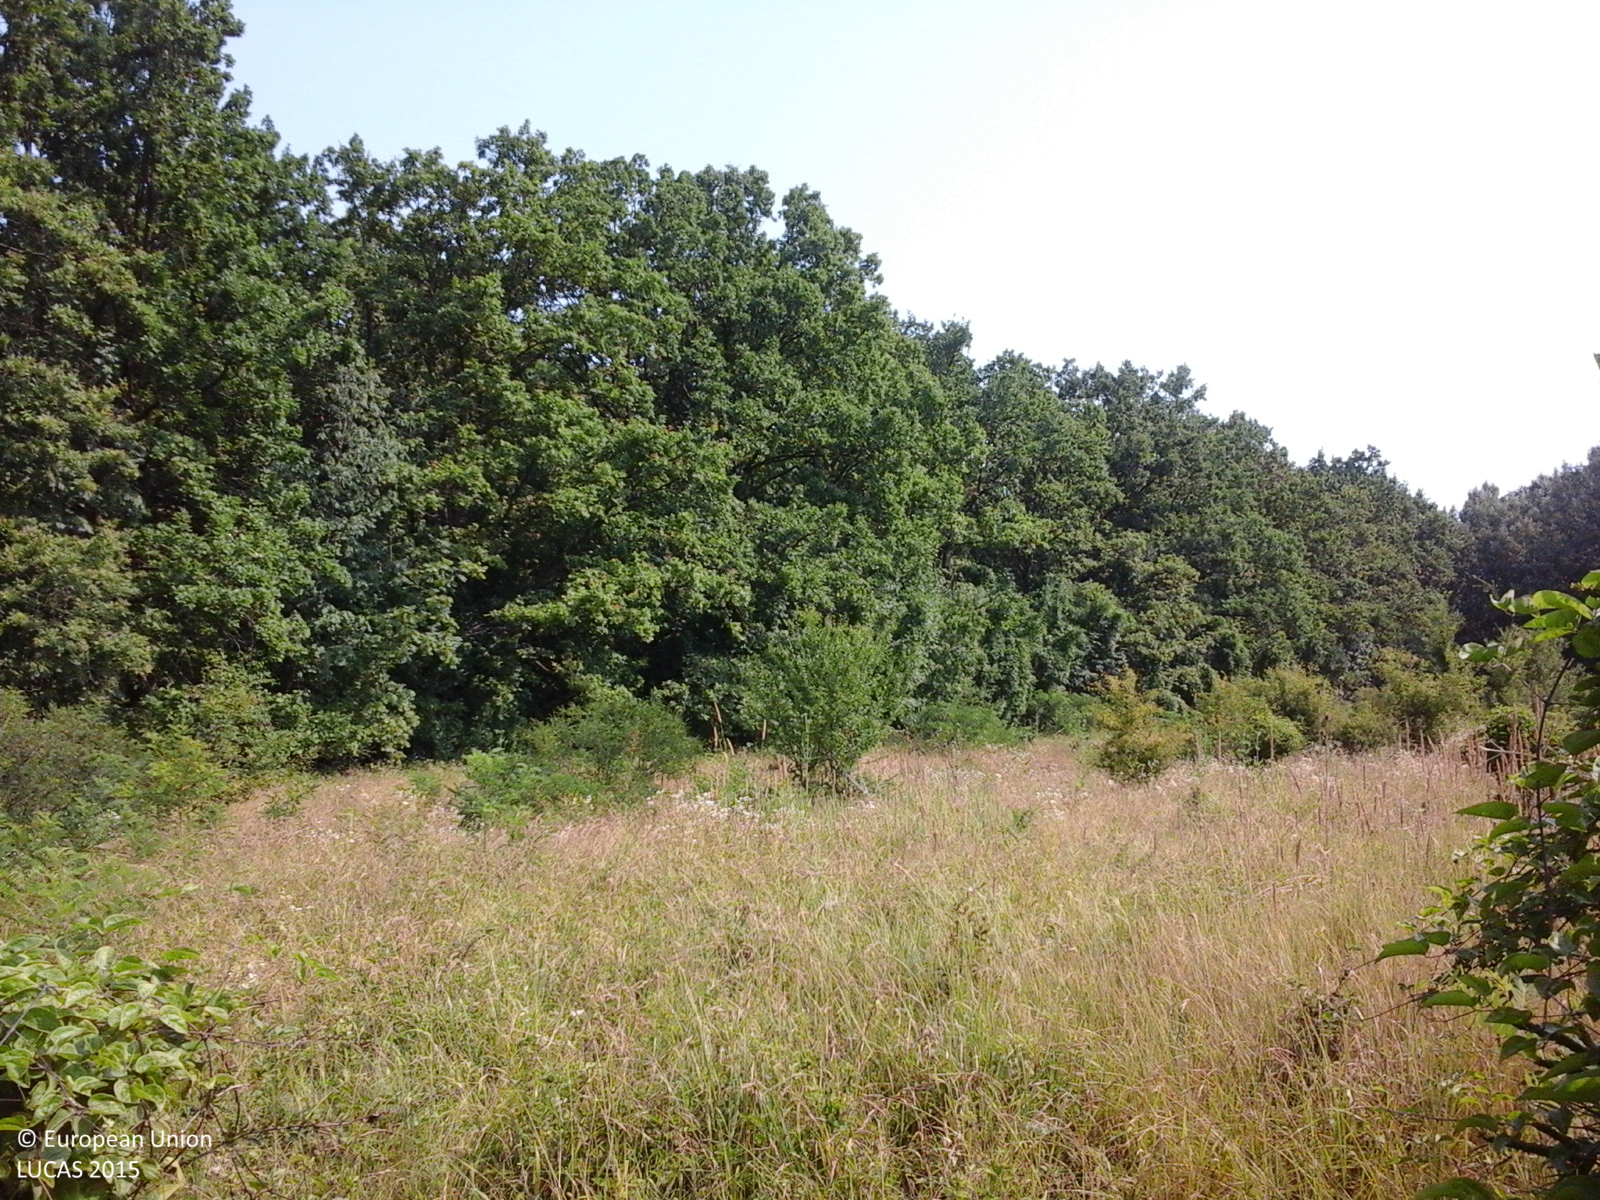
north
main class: Grassland
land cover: Grassland with sparse tree/shrub cover
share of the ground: > 75 %
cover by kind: herbaceous plants 85 %, shrubs 10 %, broadleaved forest trees 5 %
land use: Forestry
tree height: < 5 m
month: July
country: RO
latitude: 44.7913
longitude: 26.3316
